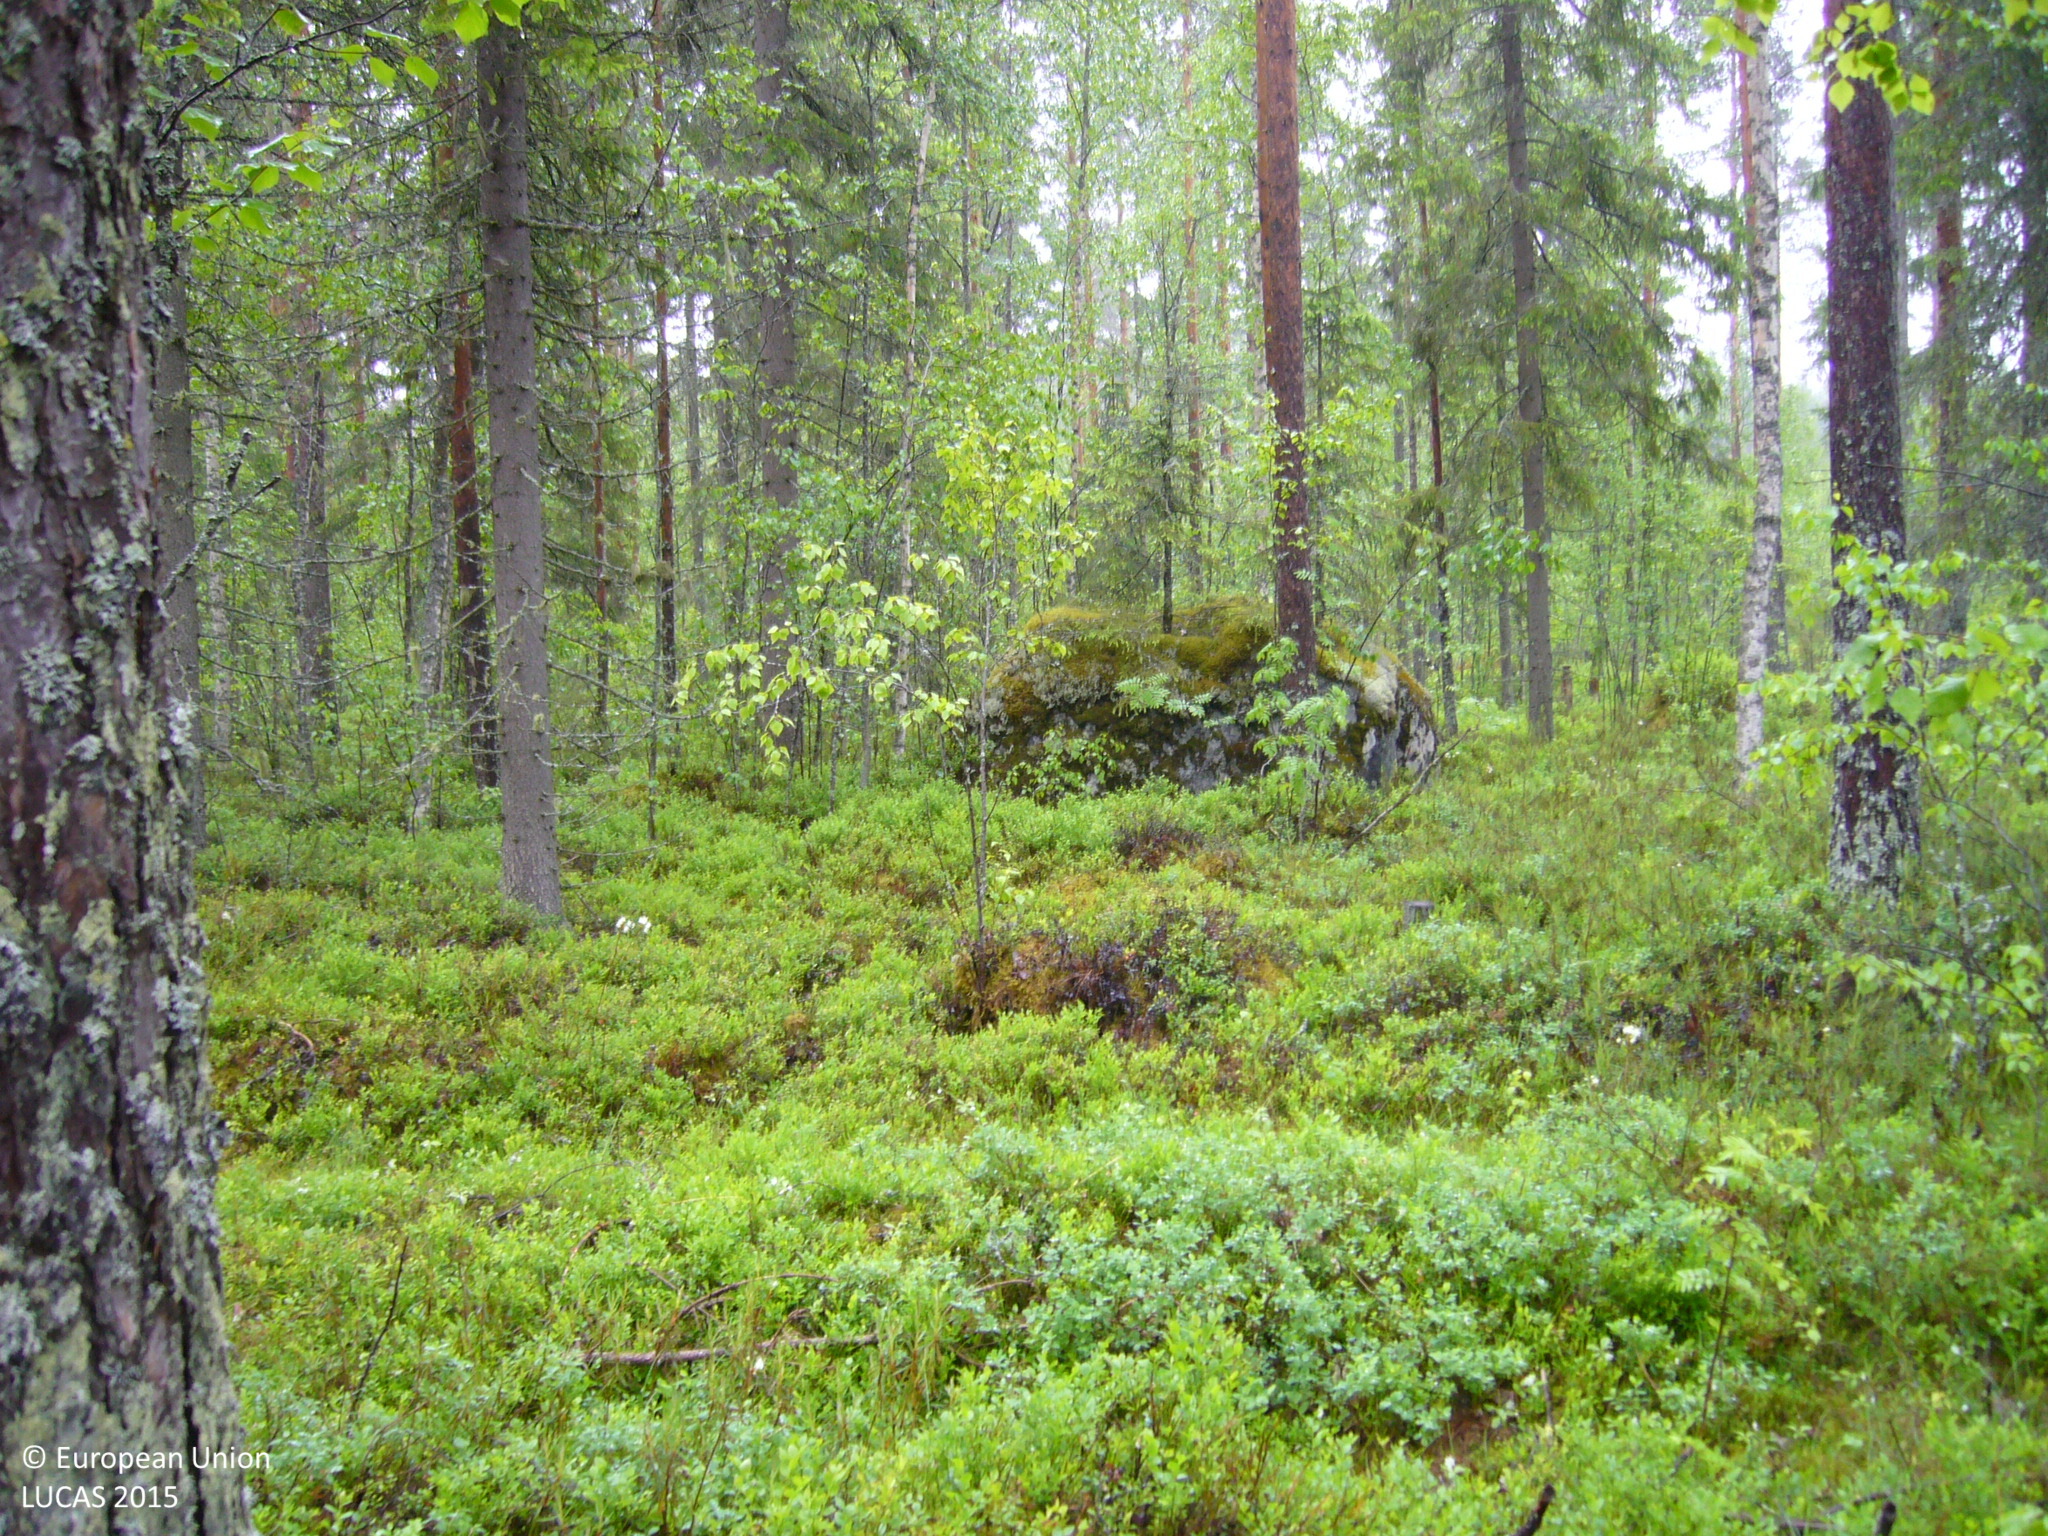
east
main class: Woodland
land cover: Pine dominated mixed woodland
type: boreal forest
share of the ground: 50 - 75 %
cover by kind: coniferous forest trees 40 %, shrubs 35 %, broadleaved forest trees 25 %
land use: Forestry
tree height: > 5 m
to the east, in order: Pine dominated mixed woodland; Tracks; Pine dominated mixed woodland; Tracks; Pine dominated mixed woodland; Tracks; Pine dominated mixed woodland; Pine dominated coniferous woodland
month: June
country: FI
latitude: 63.8036
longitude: 25.0517
